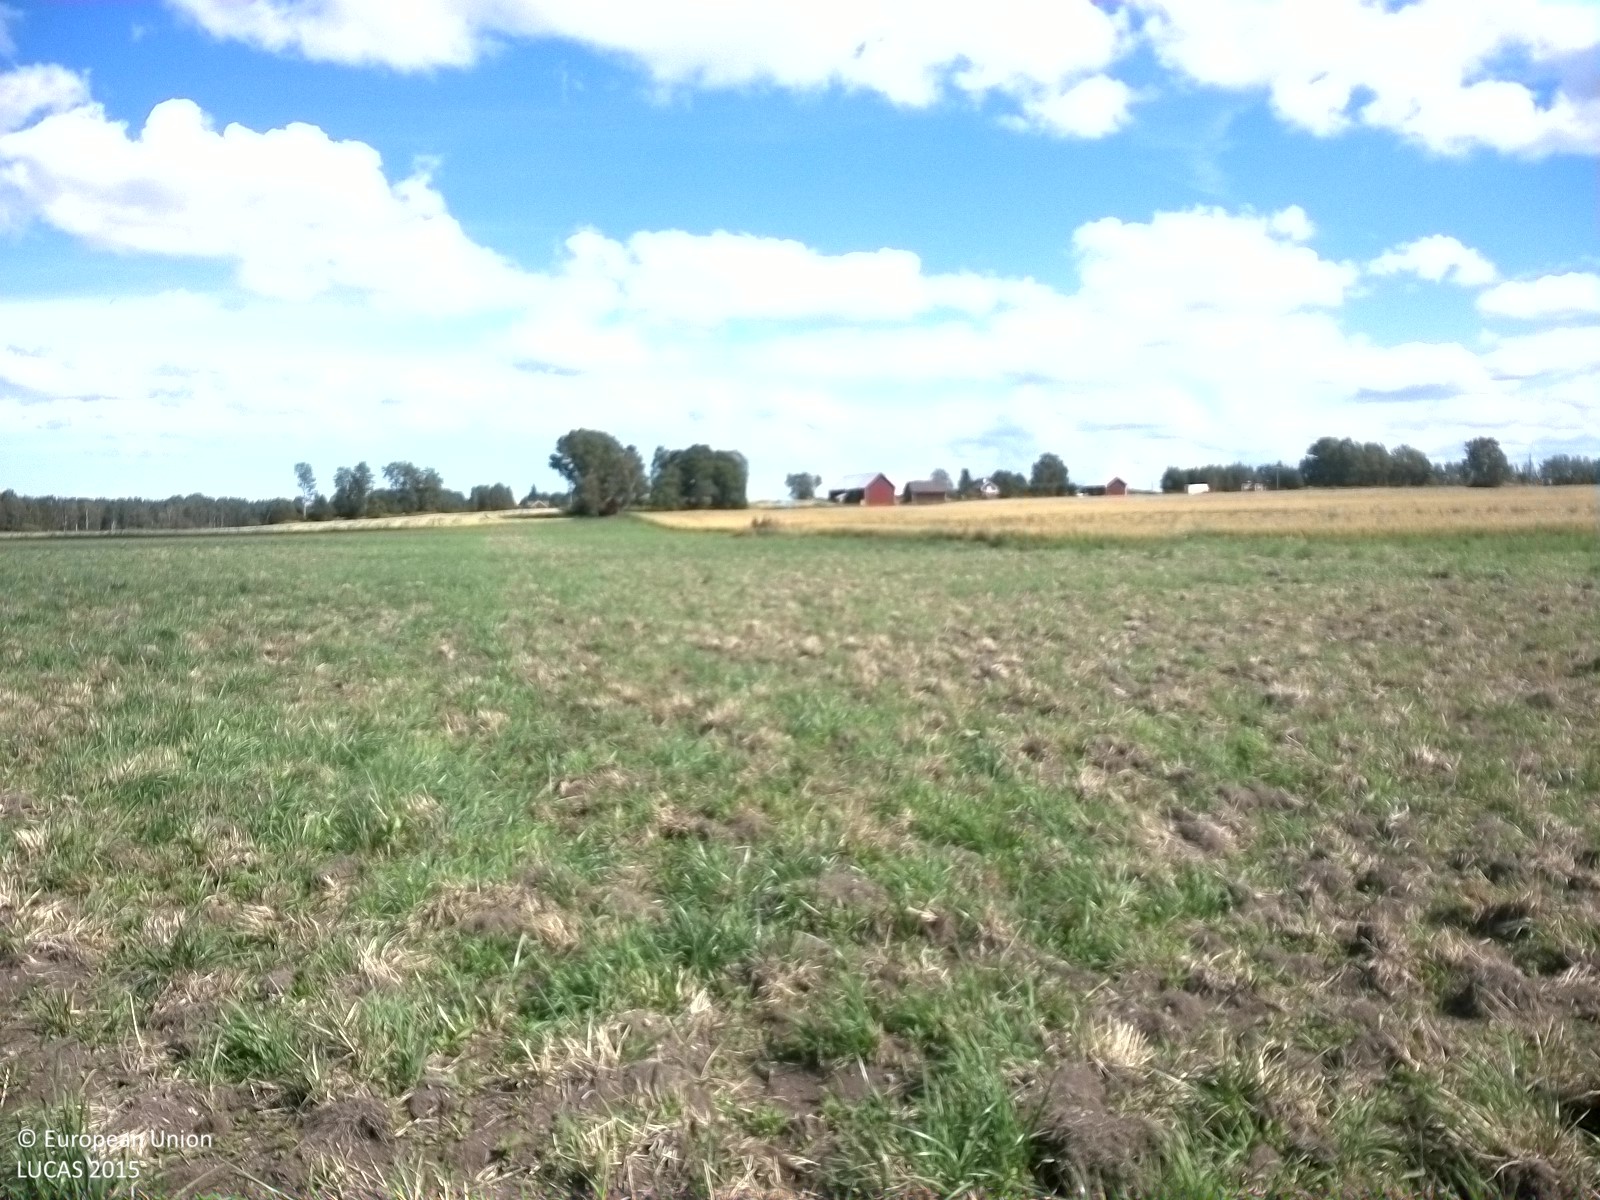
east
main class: Cropland
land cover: Temporary grasslands
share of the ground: > 75 %
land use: Agriculture (excluding fallow land and kitchen gardens)
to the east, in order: Temporary grasslands; Oats
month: August
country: SE
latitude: 59.1573
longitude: 15.3957
